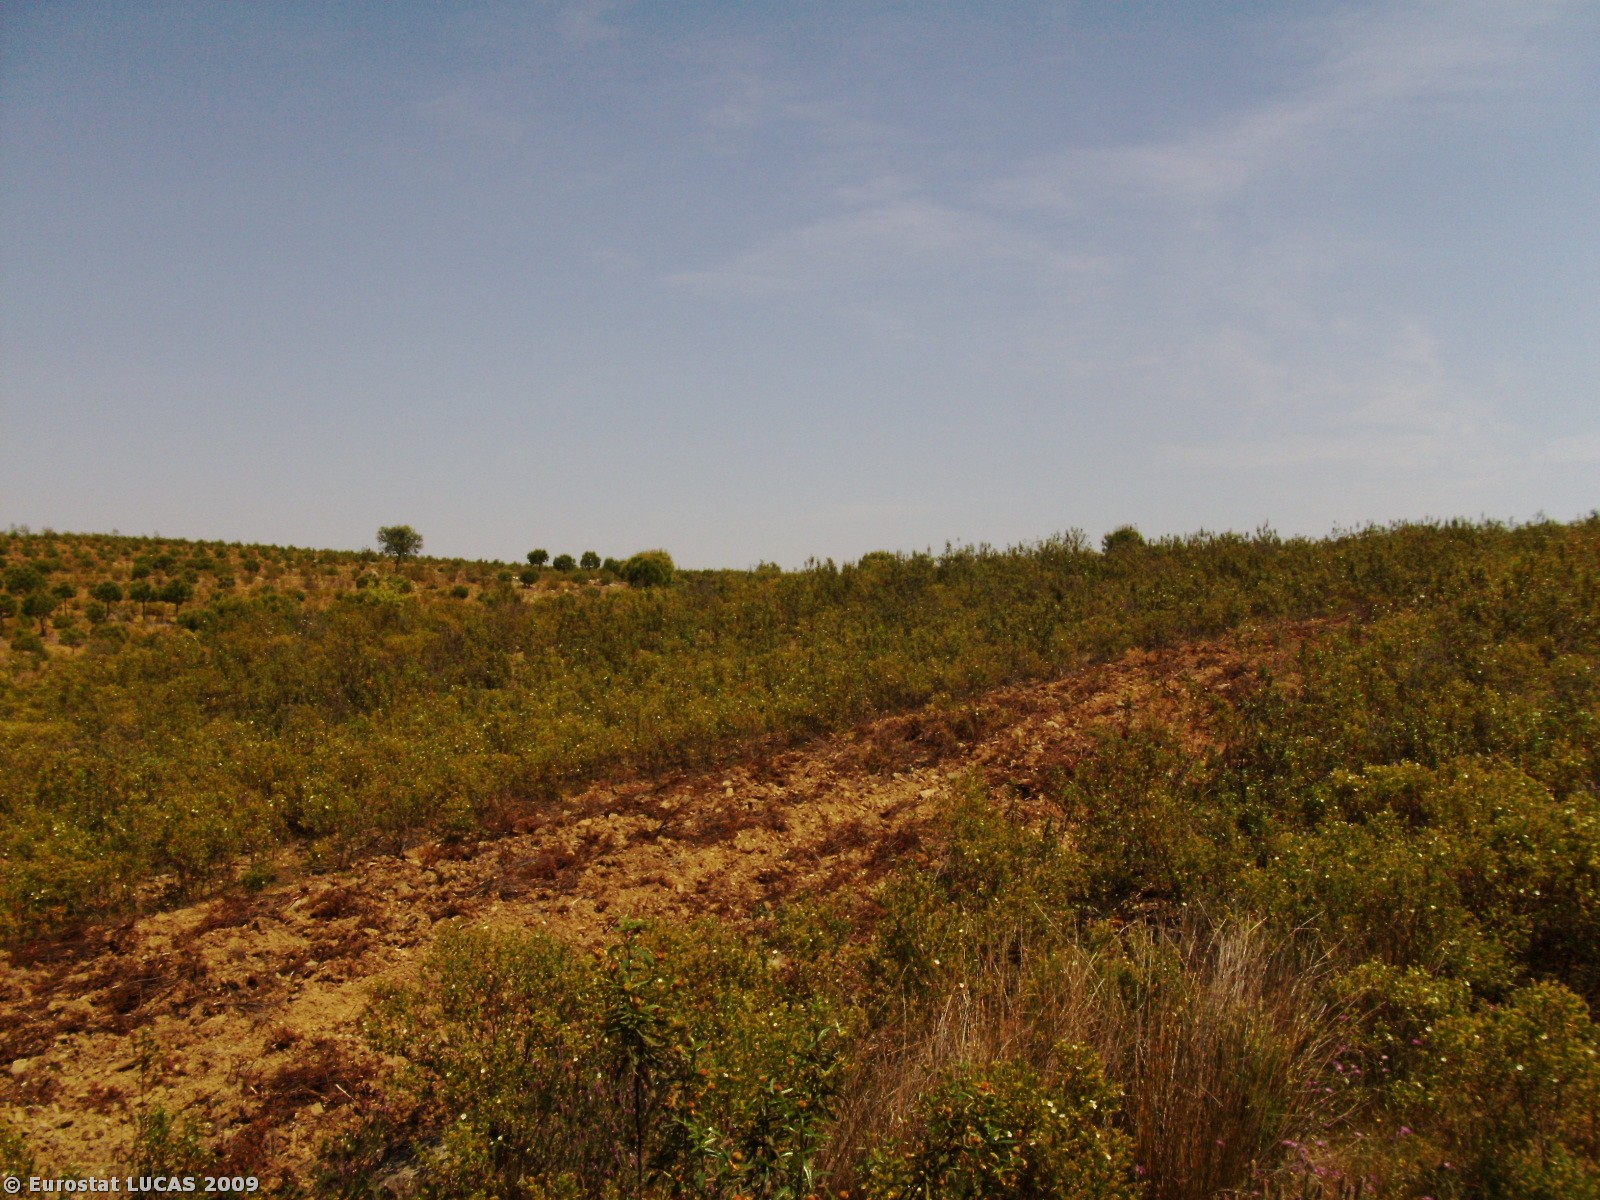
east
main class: Shrubland
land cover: Shrubland without tree cover
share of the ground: 50 - 75 %
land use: Unused
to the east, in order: Shrubland without tree cover; Rivers and streams; Shrubland without tree cover; Coniferous woodland; Tracks; Coniferous woodland; Tracks; Coniferous woodland; Shrubland without tree cover; Tracks; Shrubland without tree cover
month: May
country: PT
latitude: 37.4356
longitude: -7.5379
